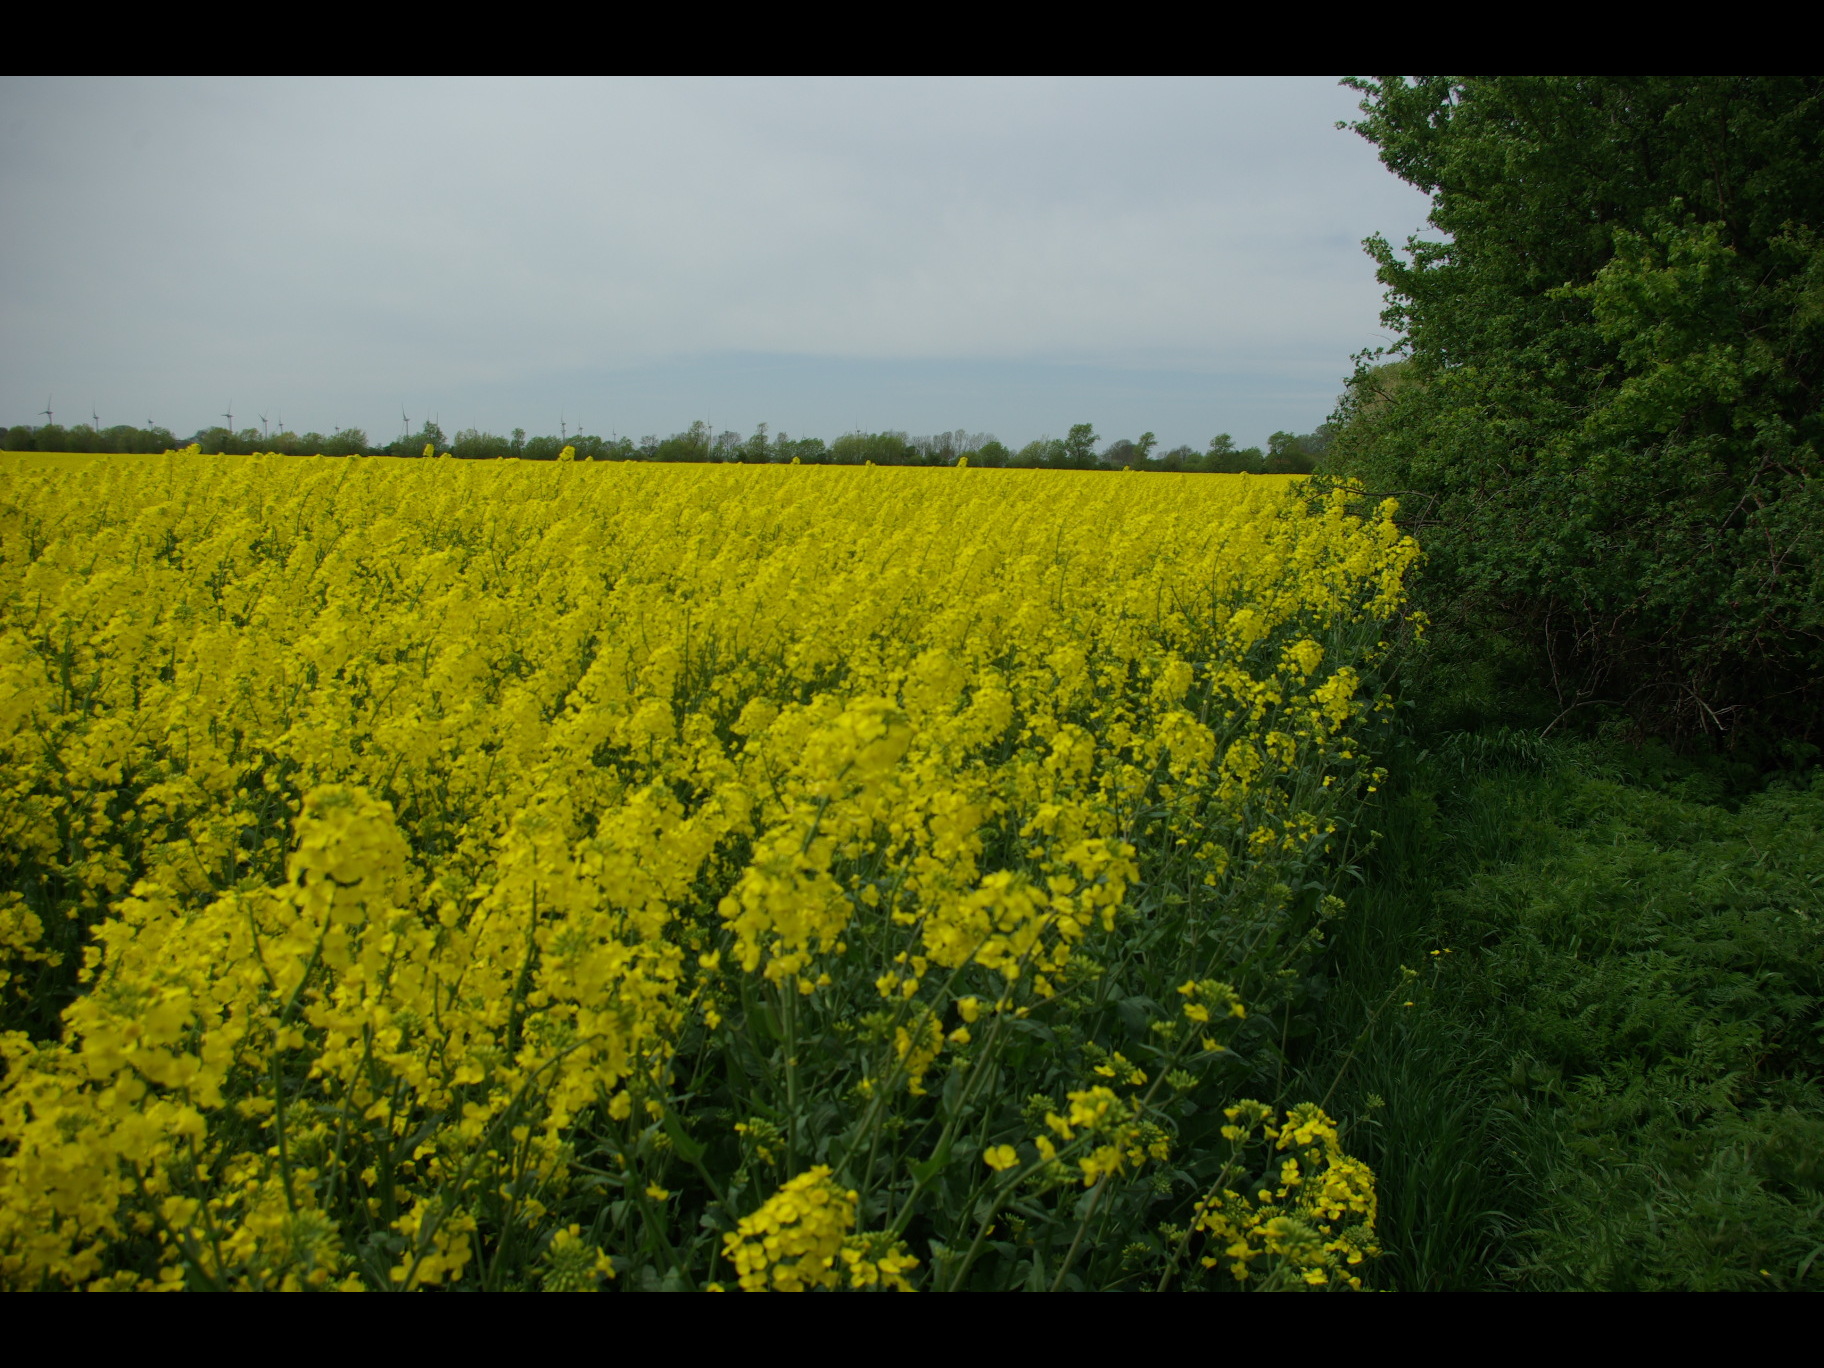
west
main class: Cropland
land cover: Rape and turnip rape
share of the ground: > 75 %
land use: Agriculture (excluding fallow land and kitchen gardens)
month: May
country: DE
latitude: 54.4928
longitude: 11.1572
